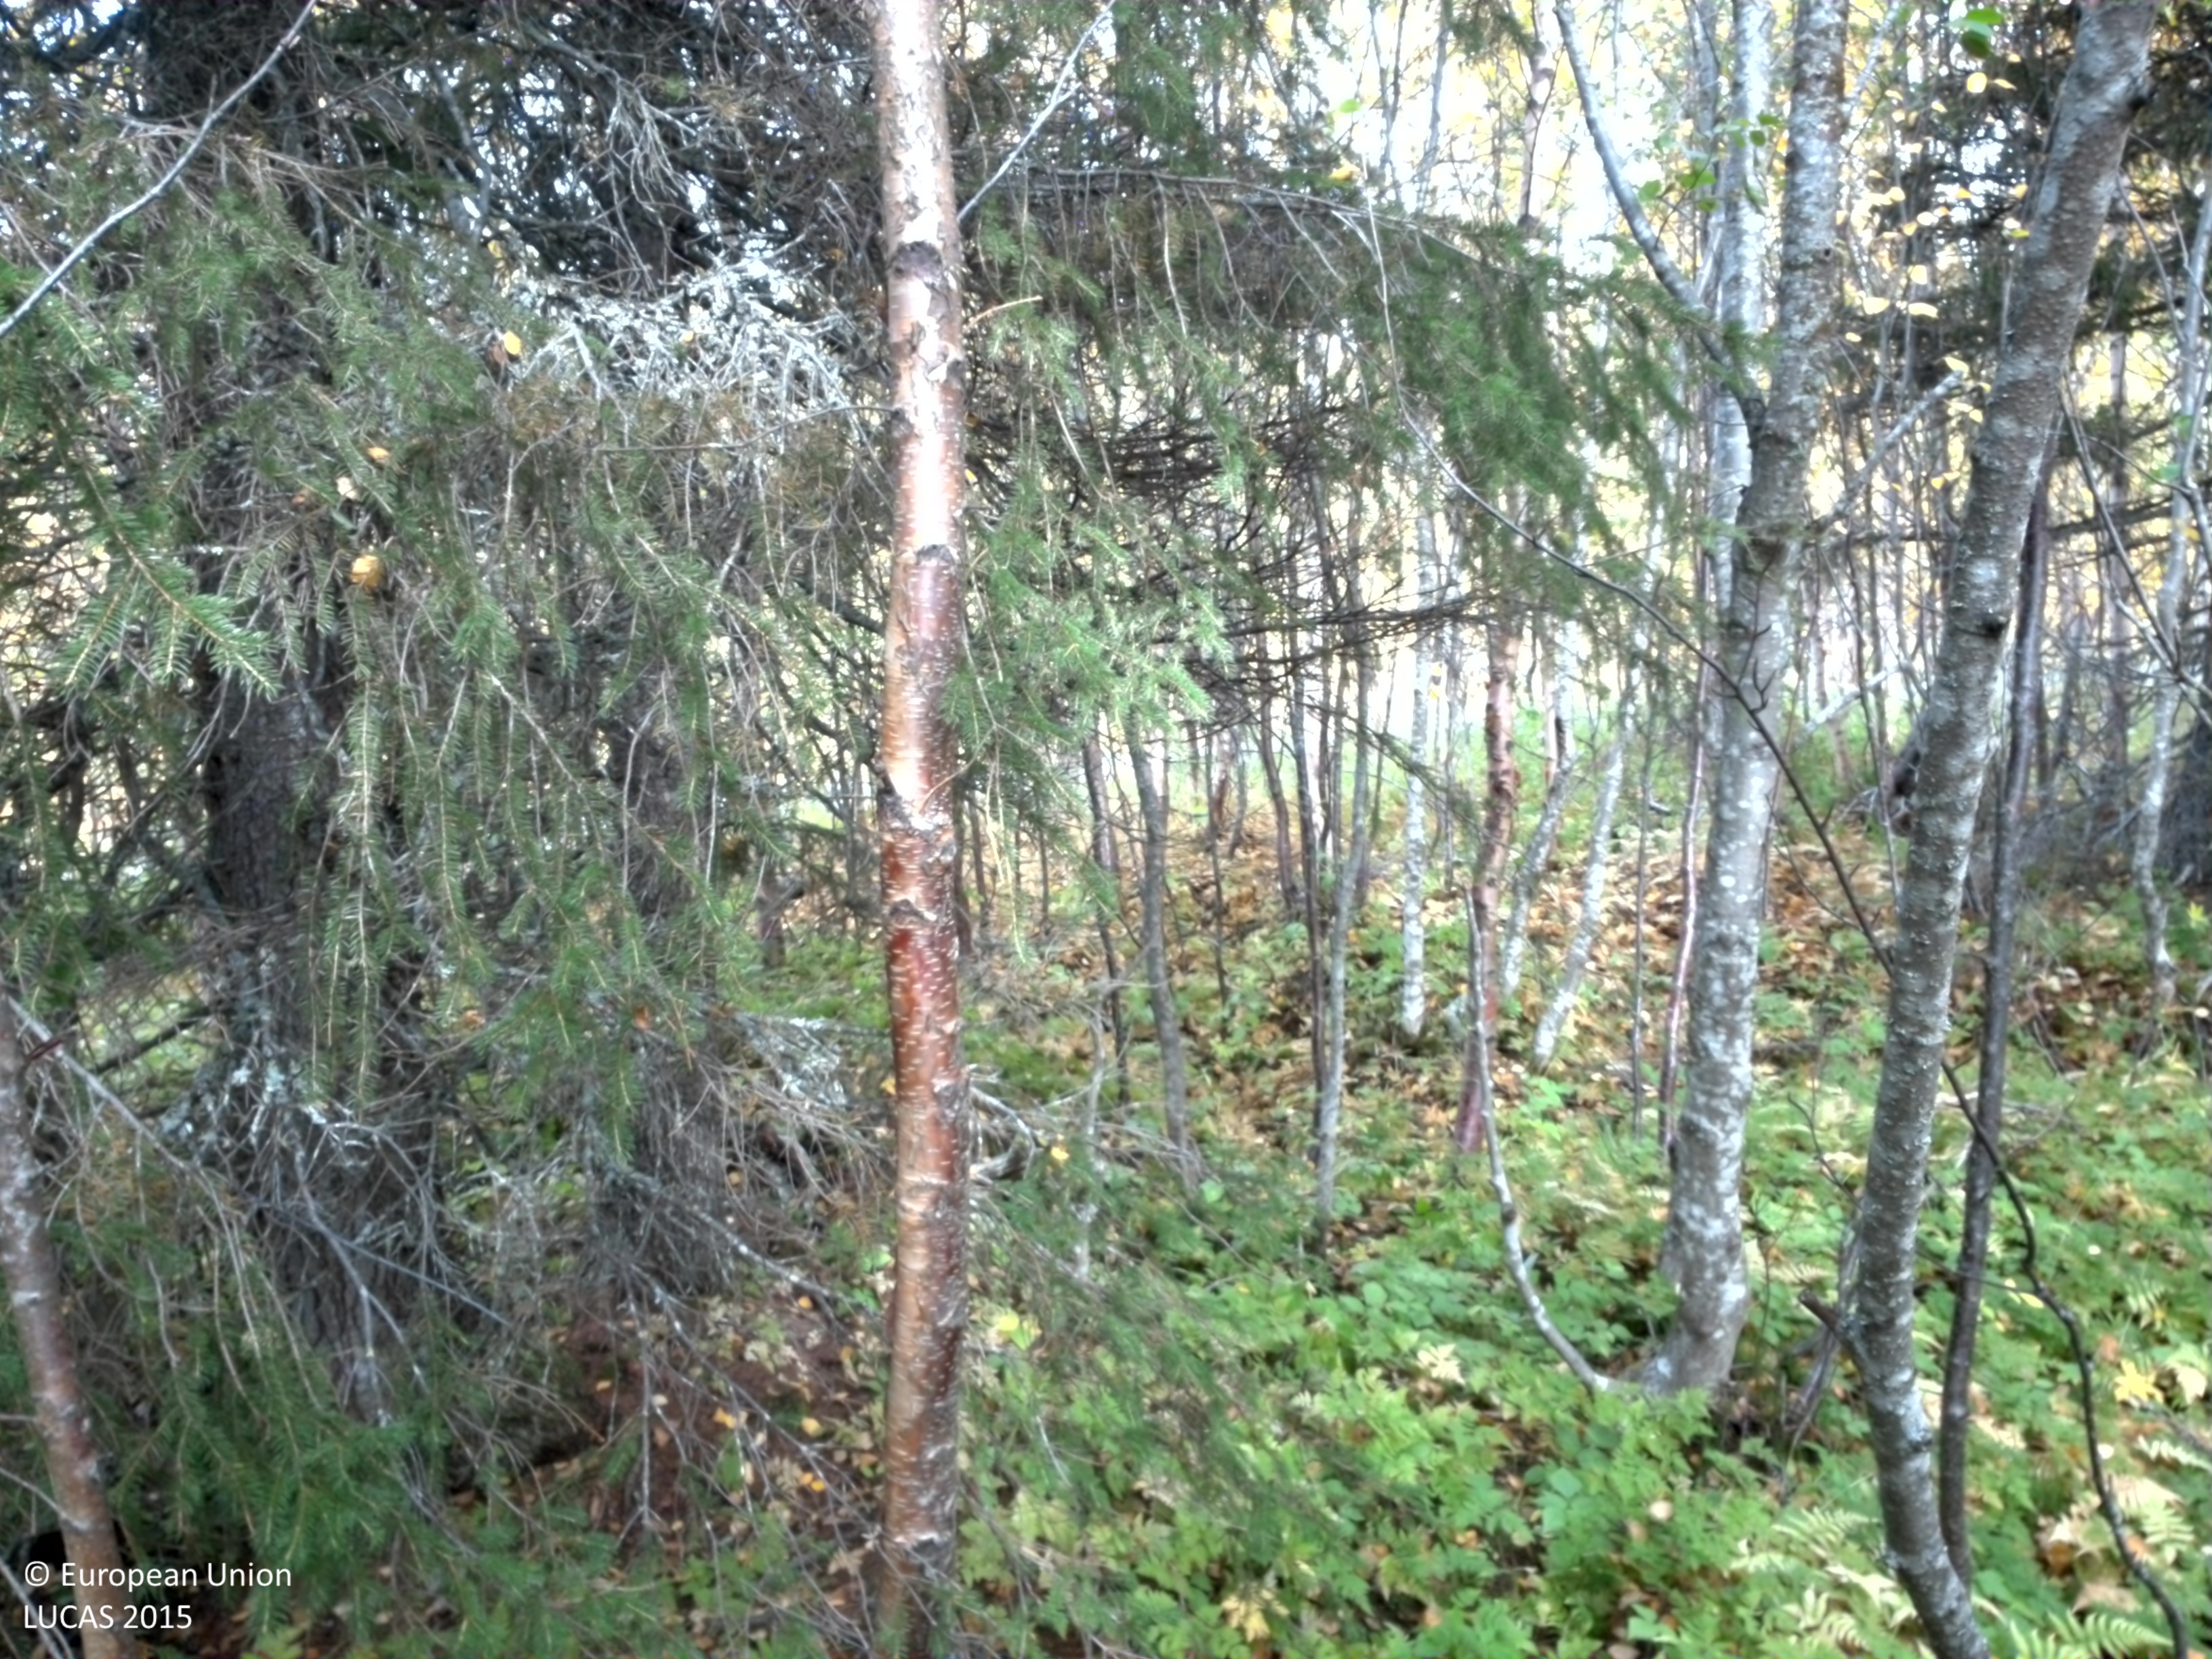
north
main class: Woodland
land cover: Broadleaved woodland
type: non-riverine alder, birch or aspen forest
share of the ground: > 75 %
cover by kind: broadleaved forest trees 70 %, herbaceous plants 15 %, coniferous forest trees 10 %, shrubs 5 %
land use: Semi-natural and natural areas not in use
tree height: > 5 m
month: September
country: SE
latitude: 65.3834
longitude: 16.1810
